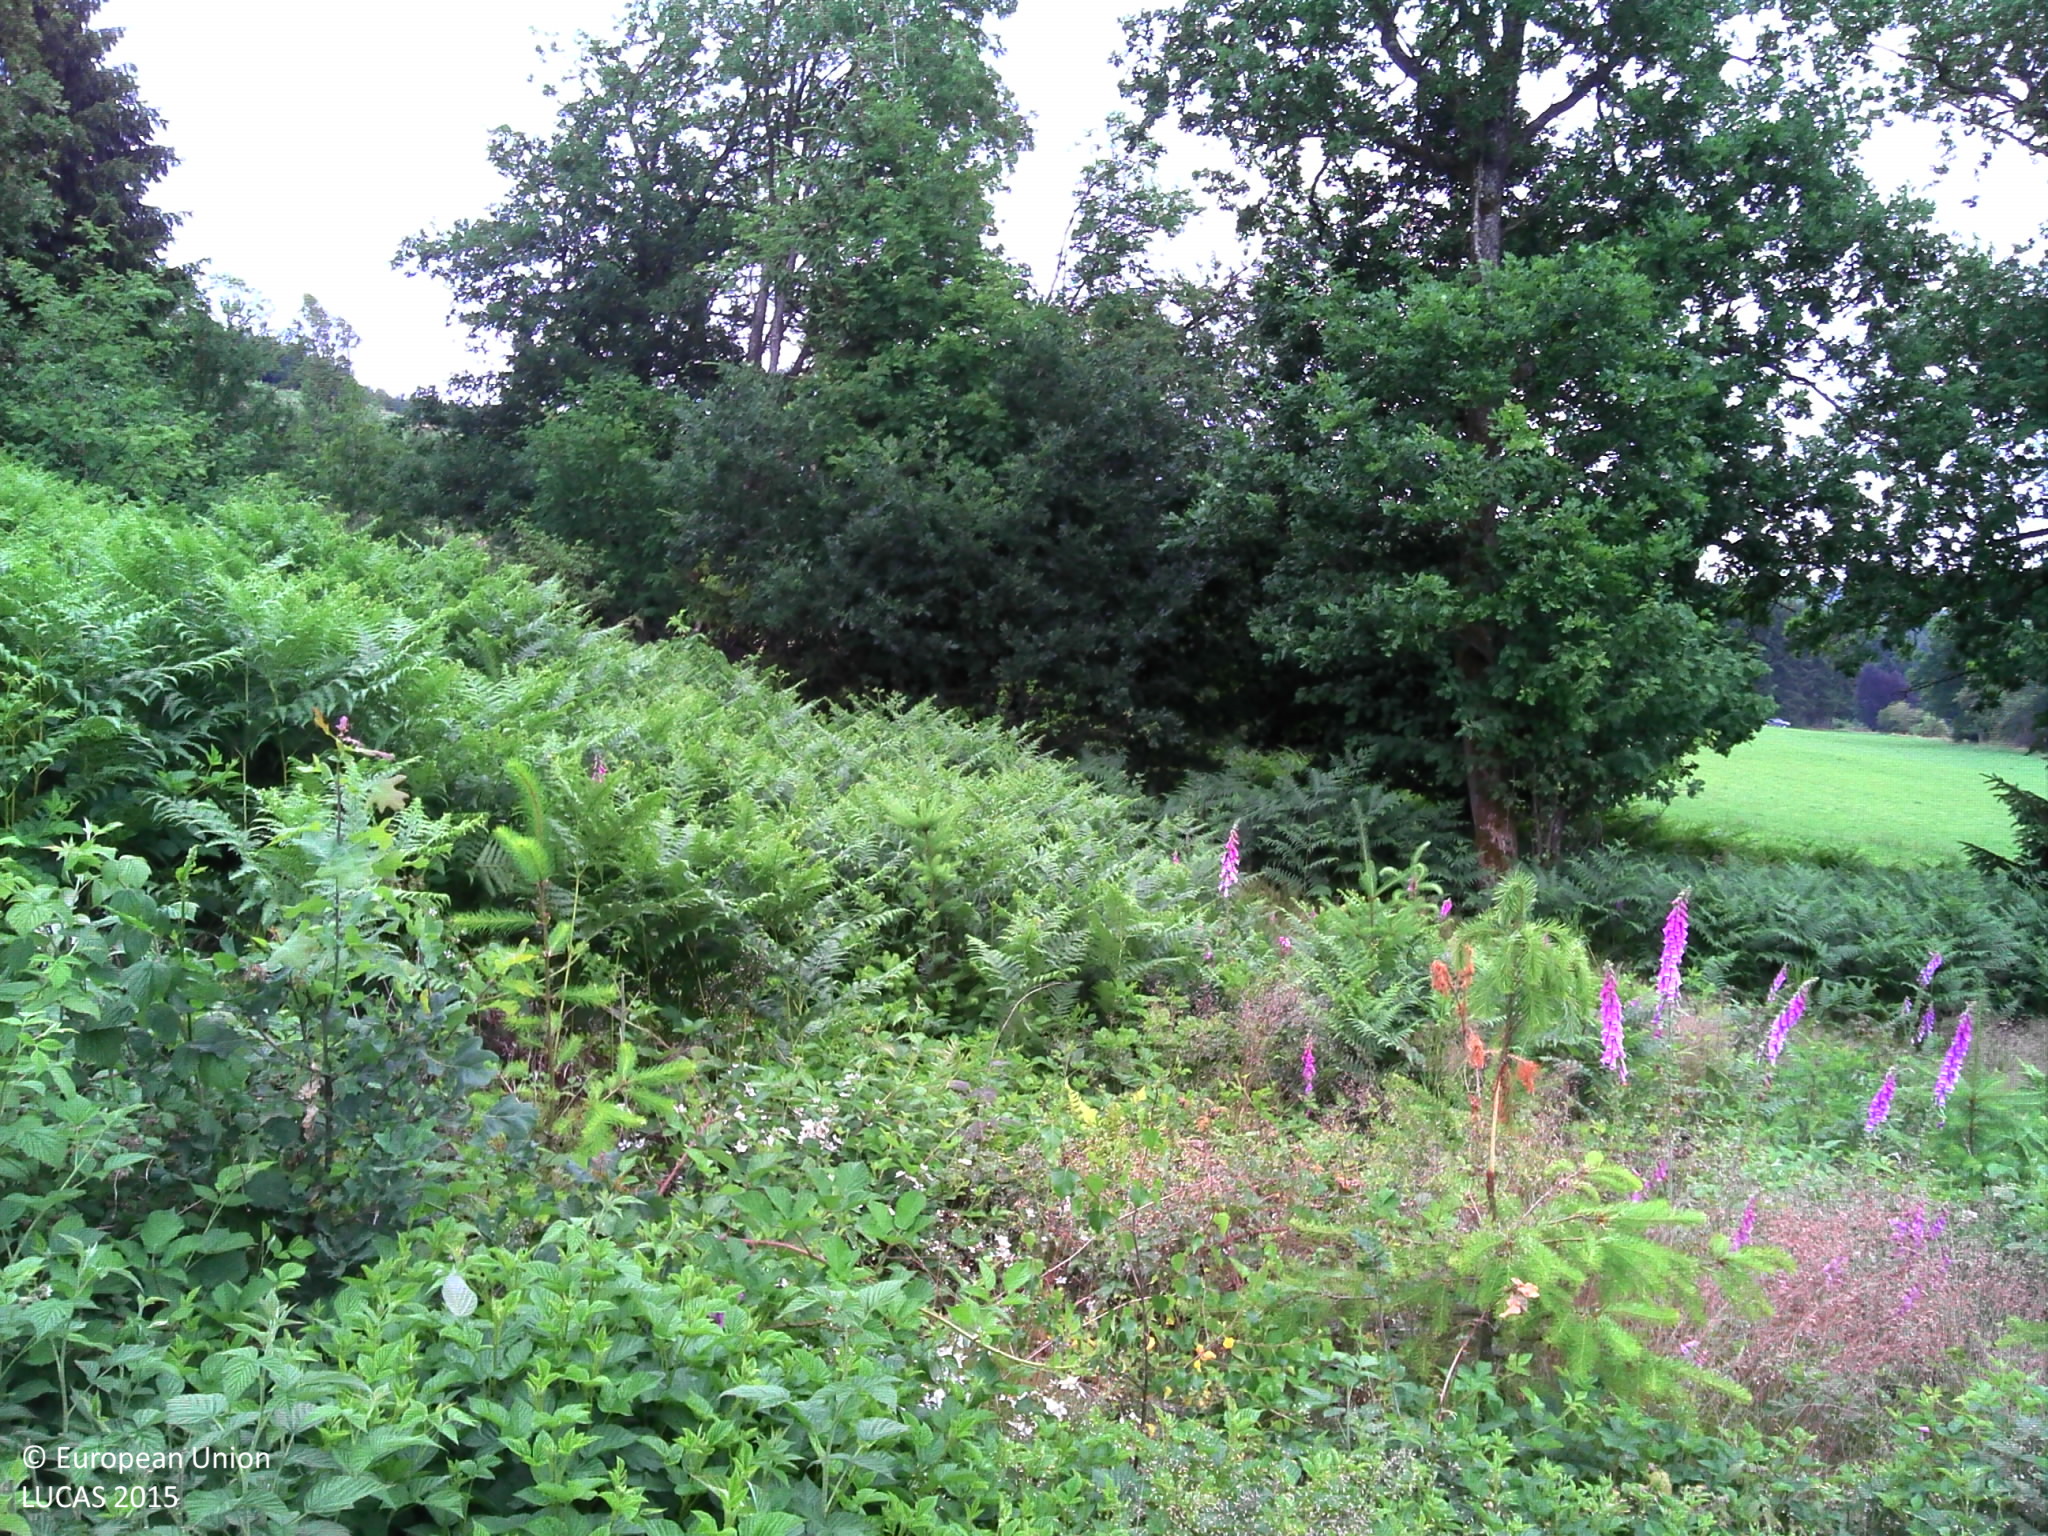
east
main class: Shrubland
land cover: Shrubland without tree cover
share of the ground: > 75 %
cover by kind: herbaceous plants 65 %, shrubs 35 %
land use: Forestry
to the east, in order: Shrubland without tree cover; Broadleaved woodland; Fences; Grassland without tree/shrub cover
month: July
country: BE
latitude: 50.2722
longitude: 5.8879
